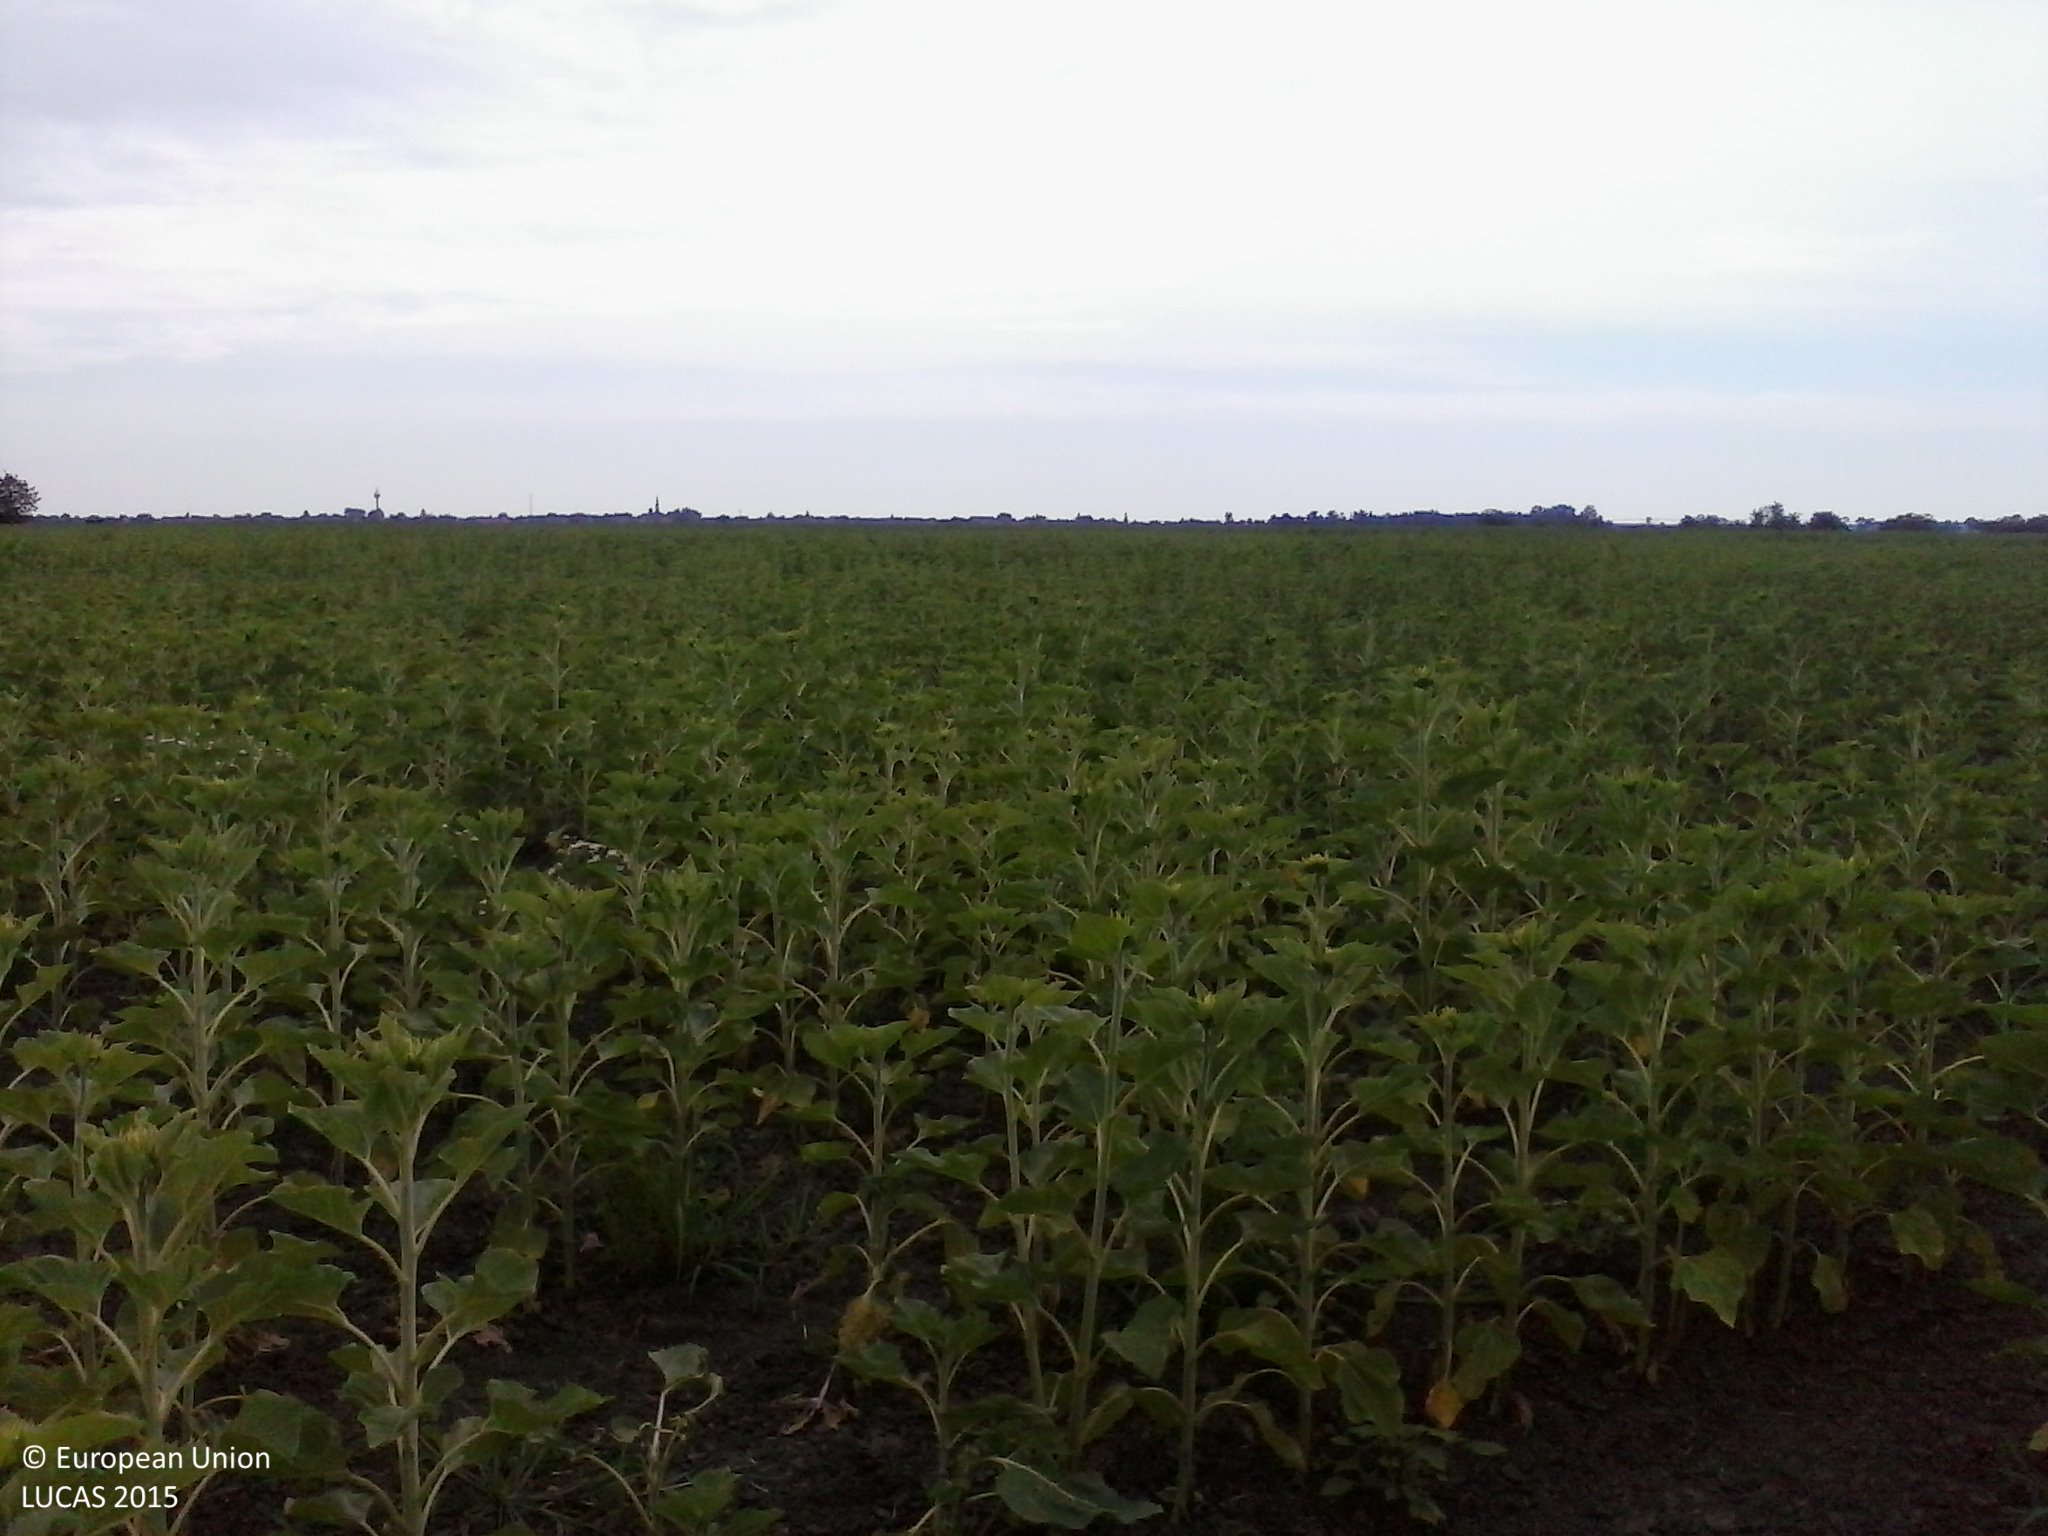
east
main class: Cropland
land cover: Sunflower
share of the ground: > 75 %
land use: Agriculture (excluding fallow land and kitchen gardens)
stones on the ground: < 10 %
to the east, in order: Sunflower
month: June
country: HU
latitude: 46.2689
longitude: 20.3131
